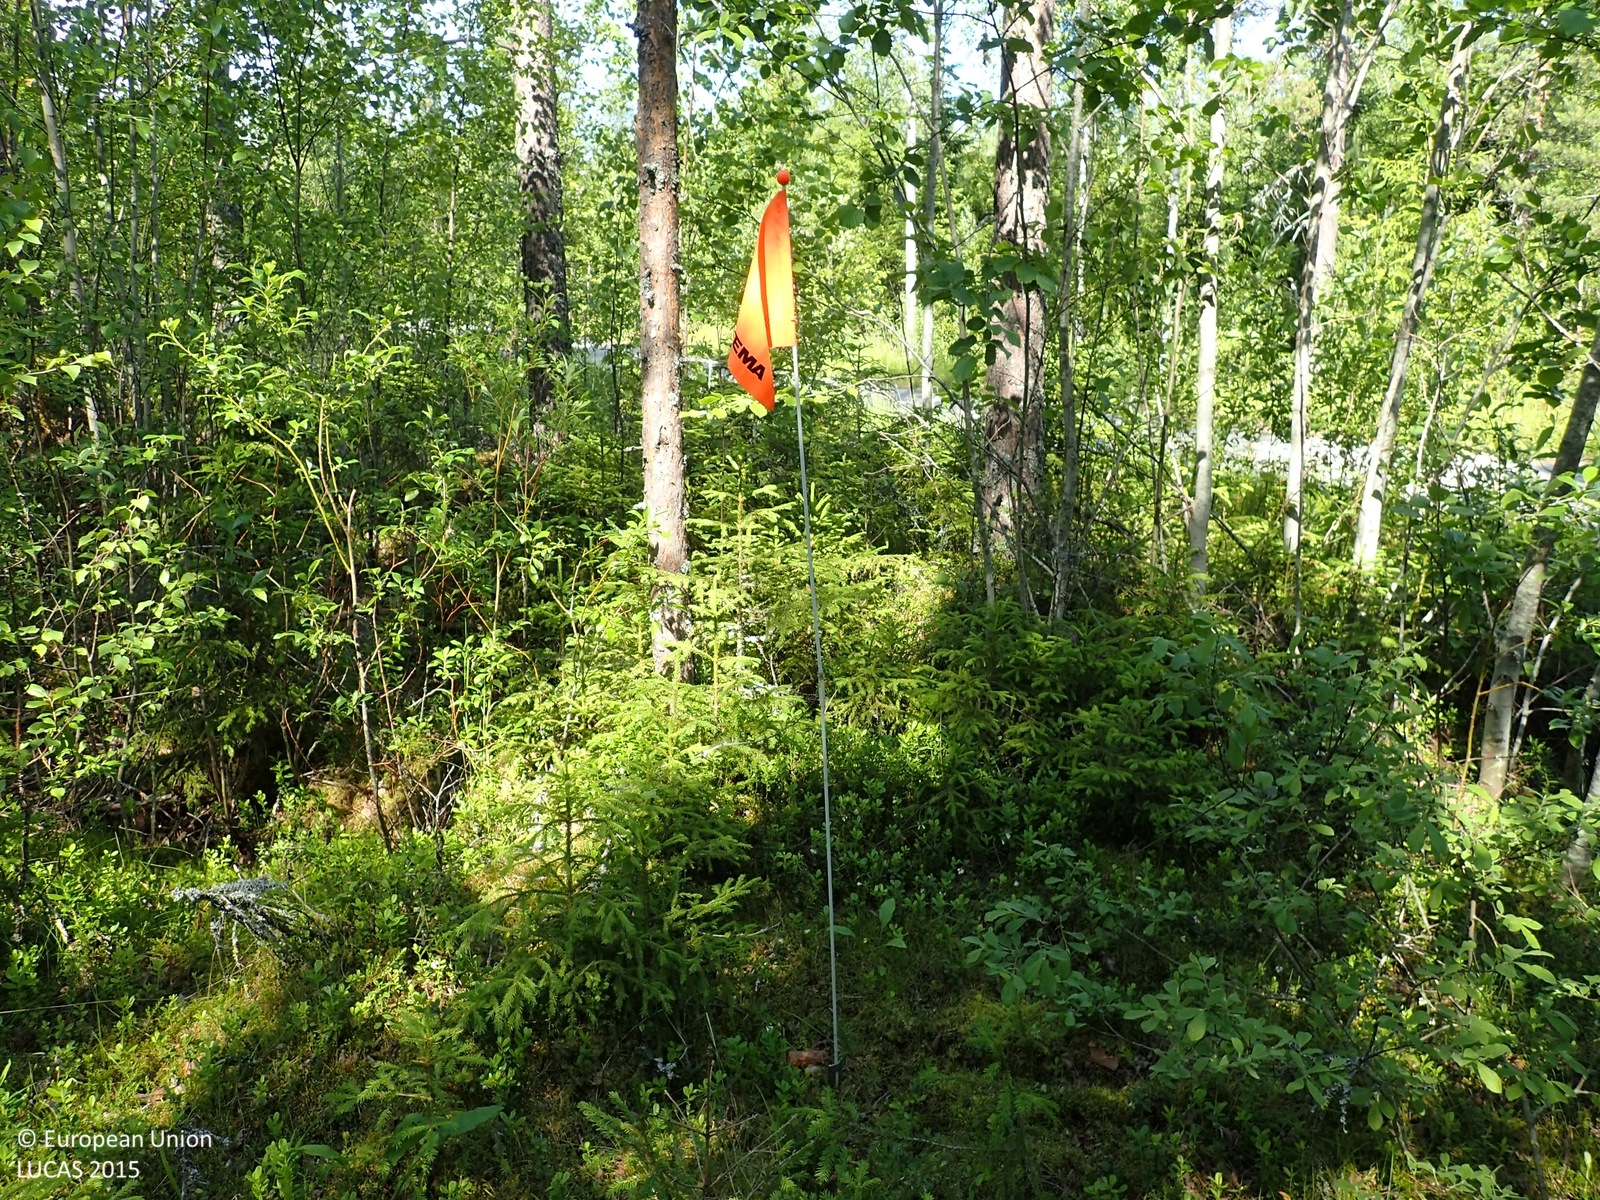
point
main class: Woodland
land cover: Pine dominated mixed woodland
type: boreal forest
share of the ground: > 75 %
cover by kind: coniferous forest trees 55 %, broadleaved forest trees 20 %, shrubs 20 %, lichens and mosses 5 %
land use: Forestry
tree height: > 5 m
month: July
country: FI
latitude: 62.8229
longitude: 21.5614
